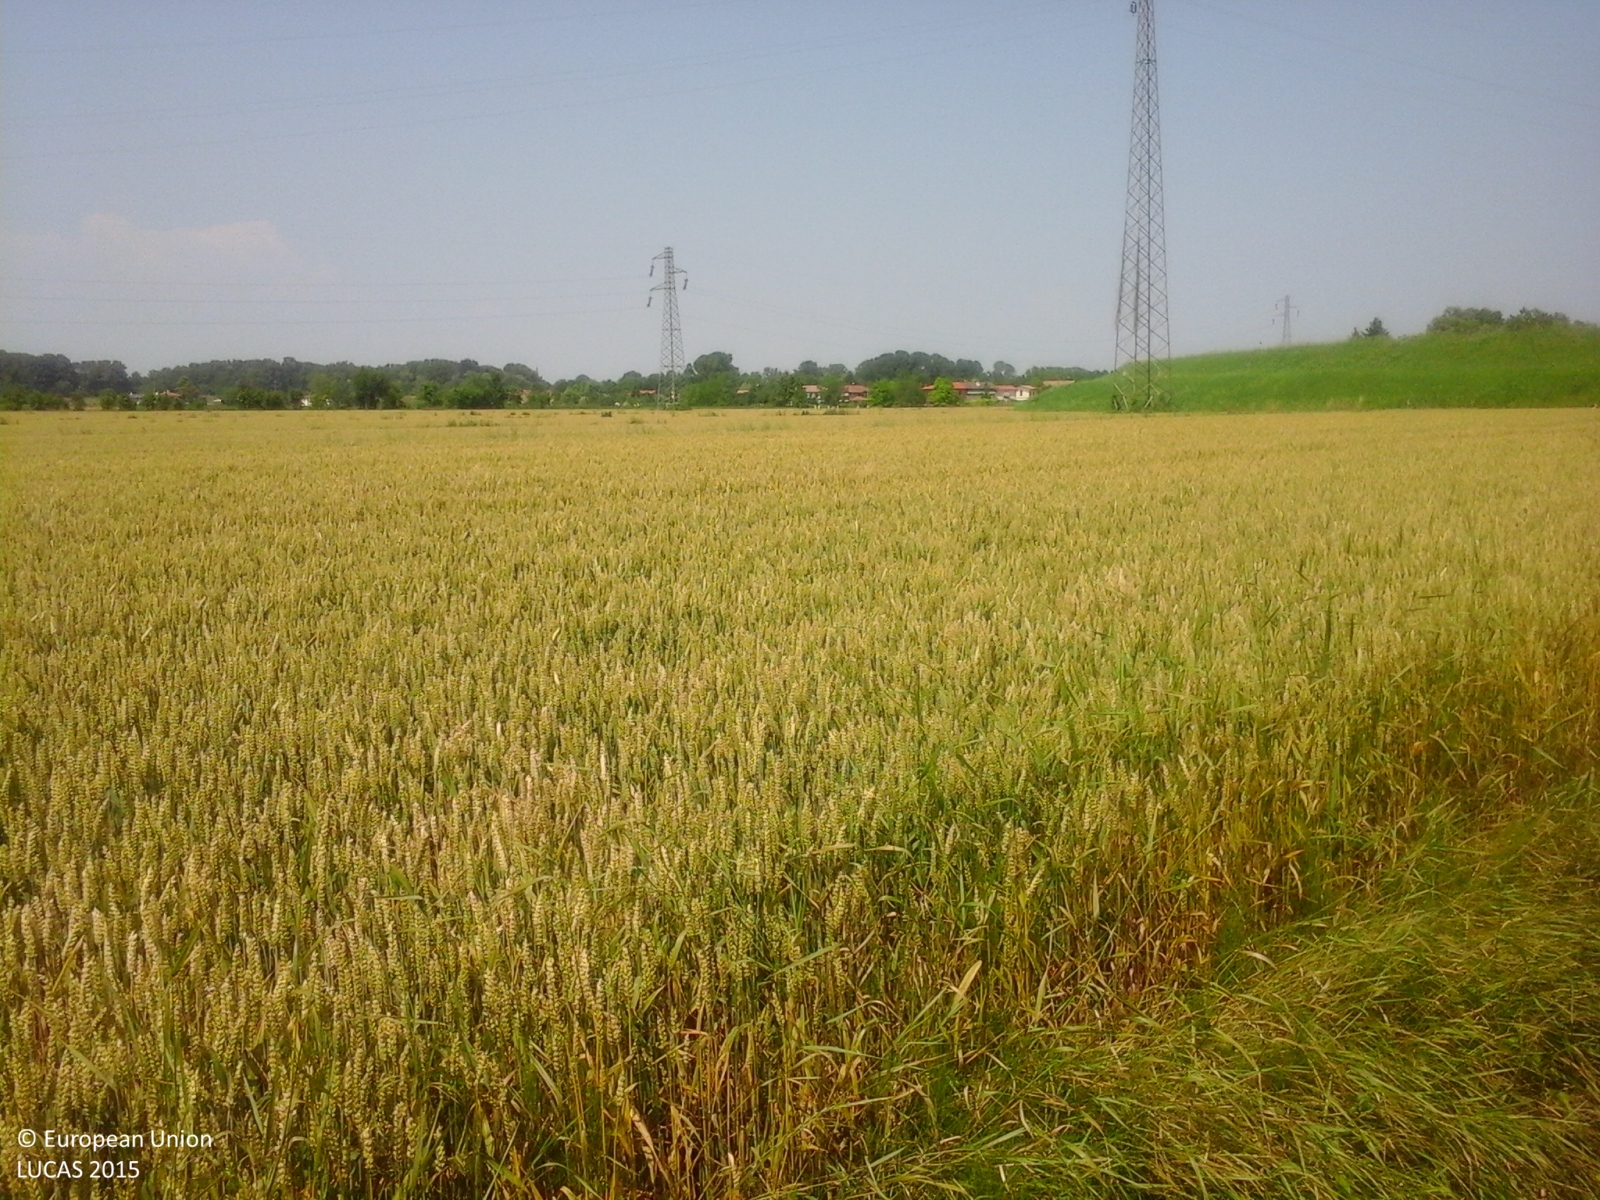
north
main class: Cropland
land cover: Common wheat
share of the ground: > 75 %
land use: Agriculture (excluding fallow land and kitchen gardens)
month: June
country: IT
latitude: 45.6365
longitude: 12.5236
